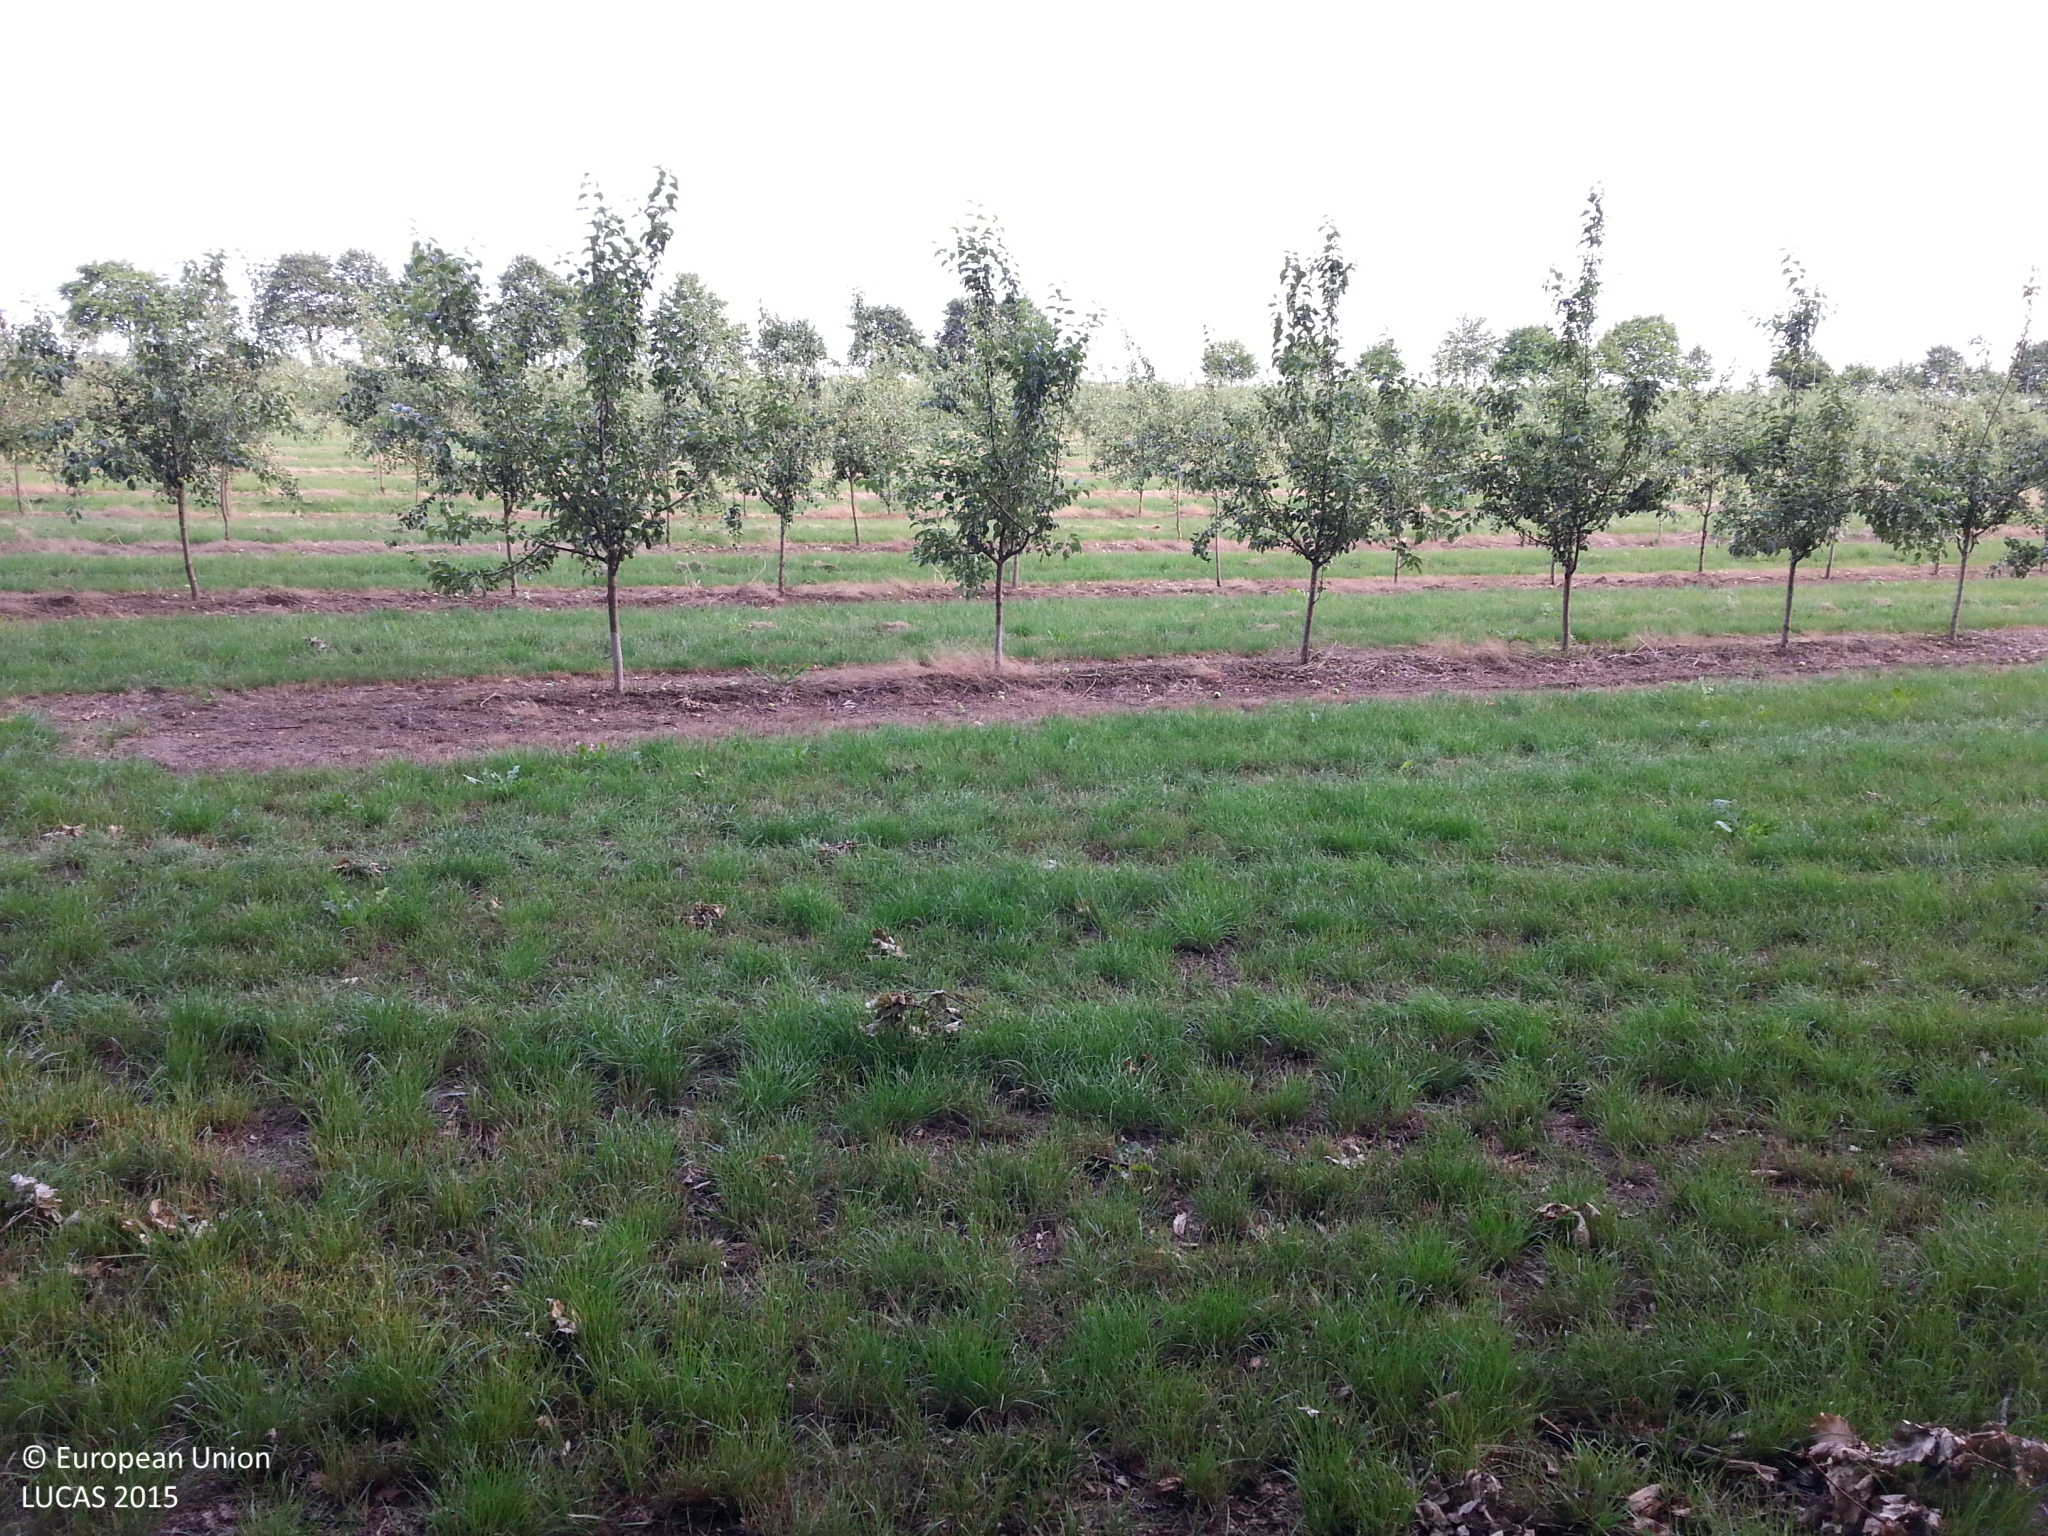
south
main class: Cropland
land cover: Apple fruit
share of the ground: 25 - 50 %
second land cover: Grassland without tree/shrub cover
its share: 50 - 75 %
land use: Agriculture (excluding fallow land and kitchen gardens)
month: July
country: DE
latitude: 53.3969
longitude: 11.0974
